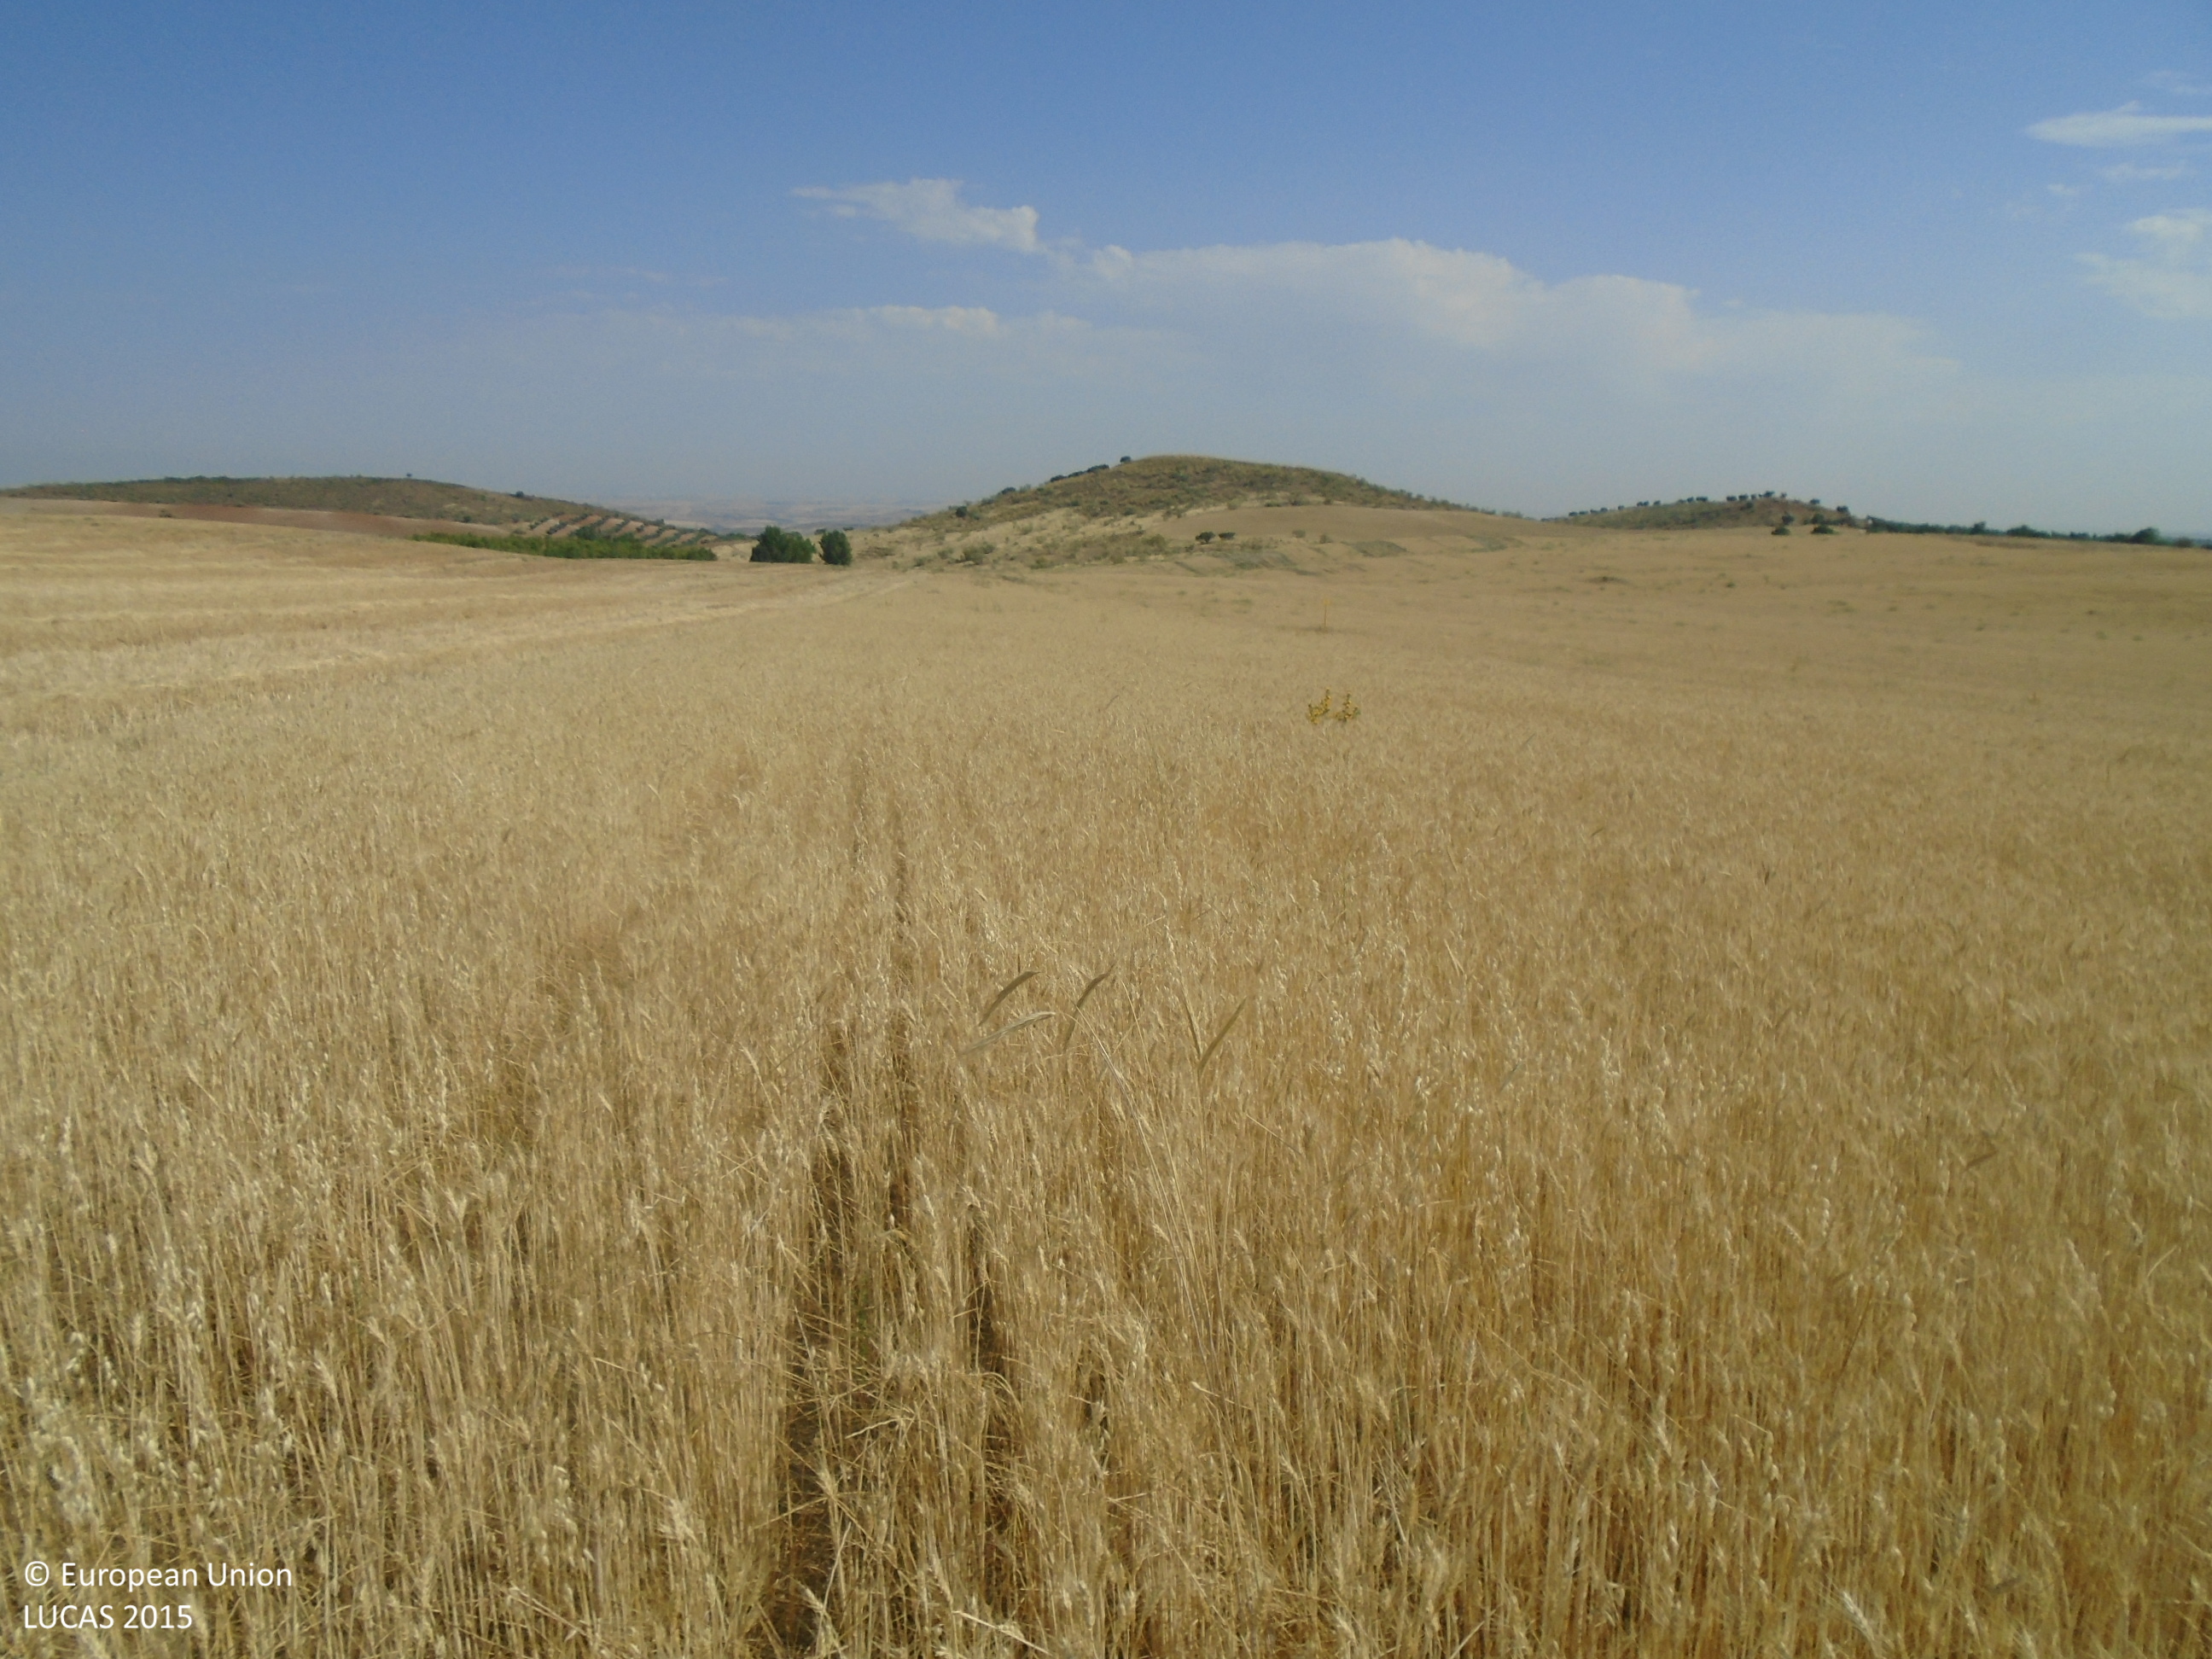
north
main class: Cropland
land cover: Common wheat
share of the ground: > 75 %
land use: Agriculture (excluding fallow land and kitchen gardens)
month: June
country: ES
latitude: 39.7791
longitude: -4.1983
